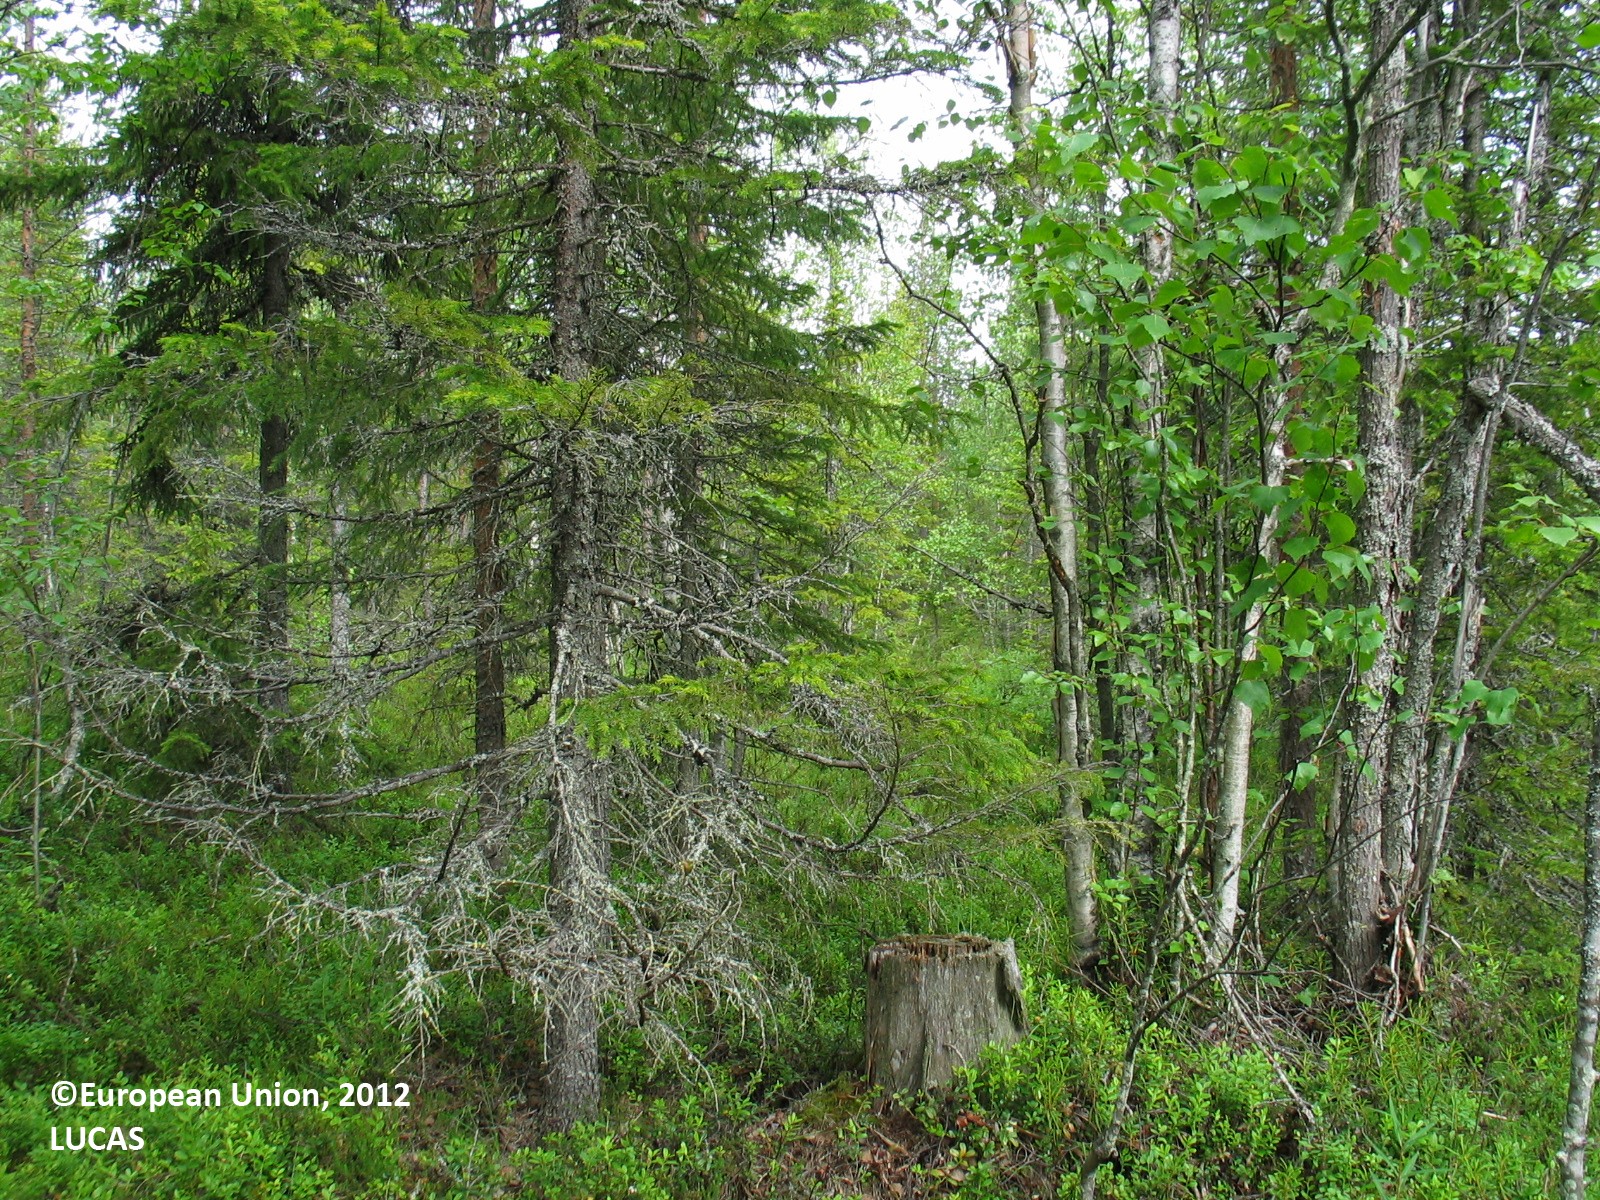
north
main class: Woodland
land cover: Other mixed woodland
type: mire and swamp forests
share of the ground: 25 - 50 %
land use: Forestry
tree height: > 5 m
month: July
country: FI
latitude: 66.0442
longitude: 25.4079
